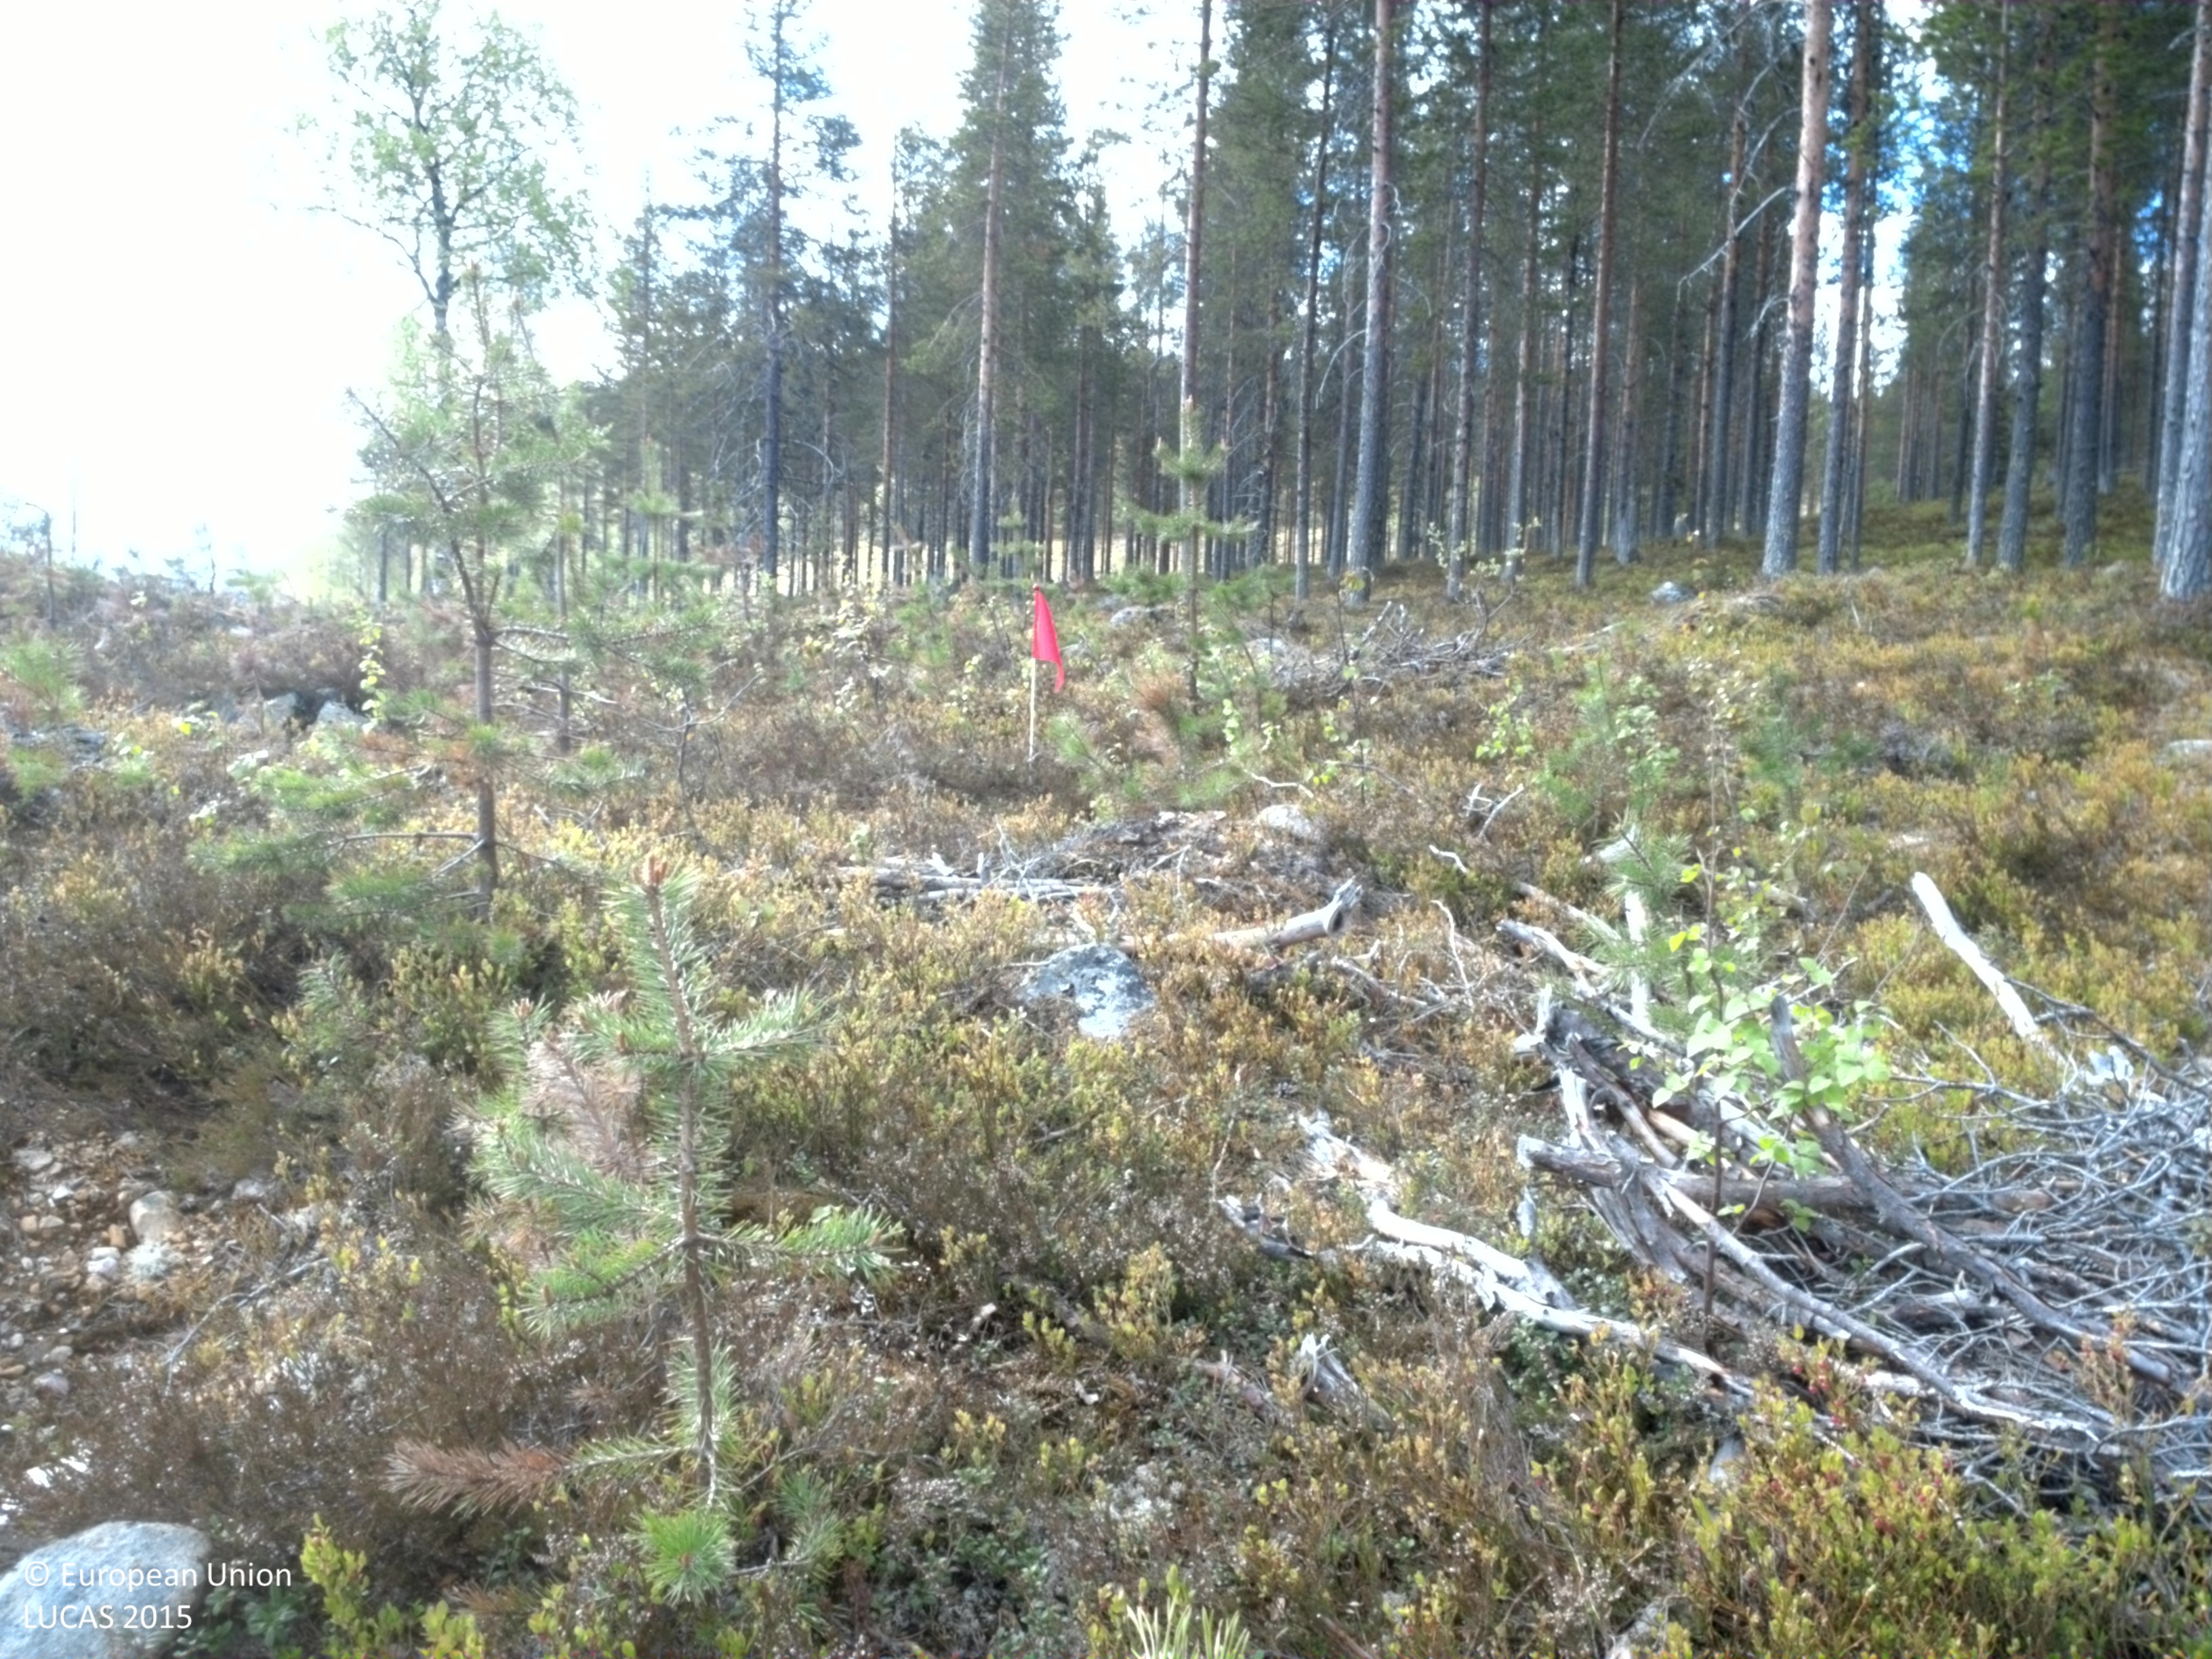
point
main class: Shrubland
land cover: Shrubland with sparse tree cover
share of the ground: > 75 %
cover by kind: shrubs 85 %, coniferous forest trees 5 %, lichens and mosses 5 %, consolidated bare surface 5 %
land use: Forestry
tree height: < 5 m
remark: Clear cut
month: June
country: SE
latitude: 65.9399
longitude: 19.7408
